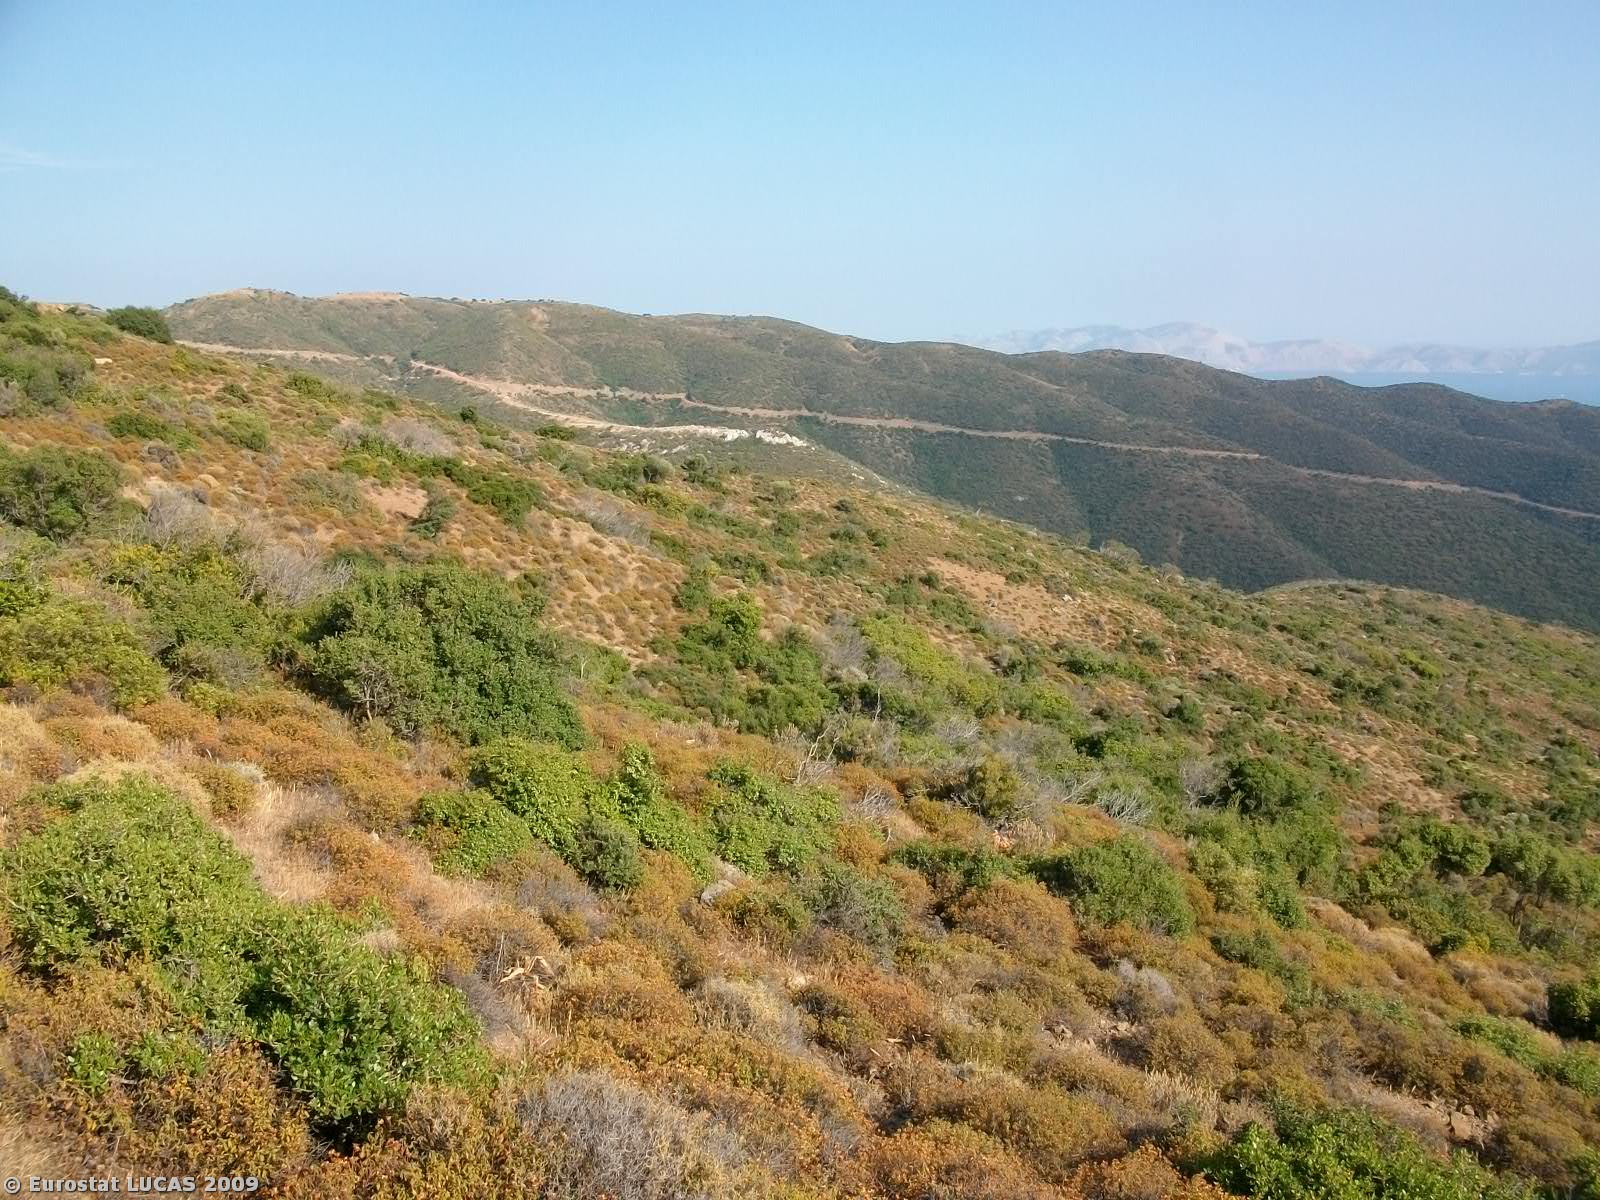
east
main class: Shrubland
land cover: Shrubland without tree cover
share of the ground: > 75 %
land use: Unused
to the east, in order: Shrubland without tree cover
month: August
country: GR
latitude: 37.4664
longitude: 23.3216
